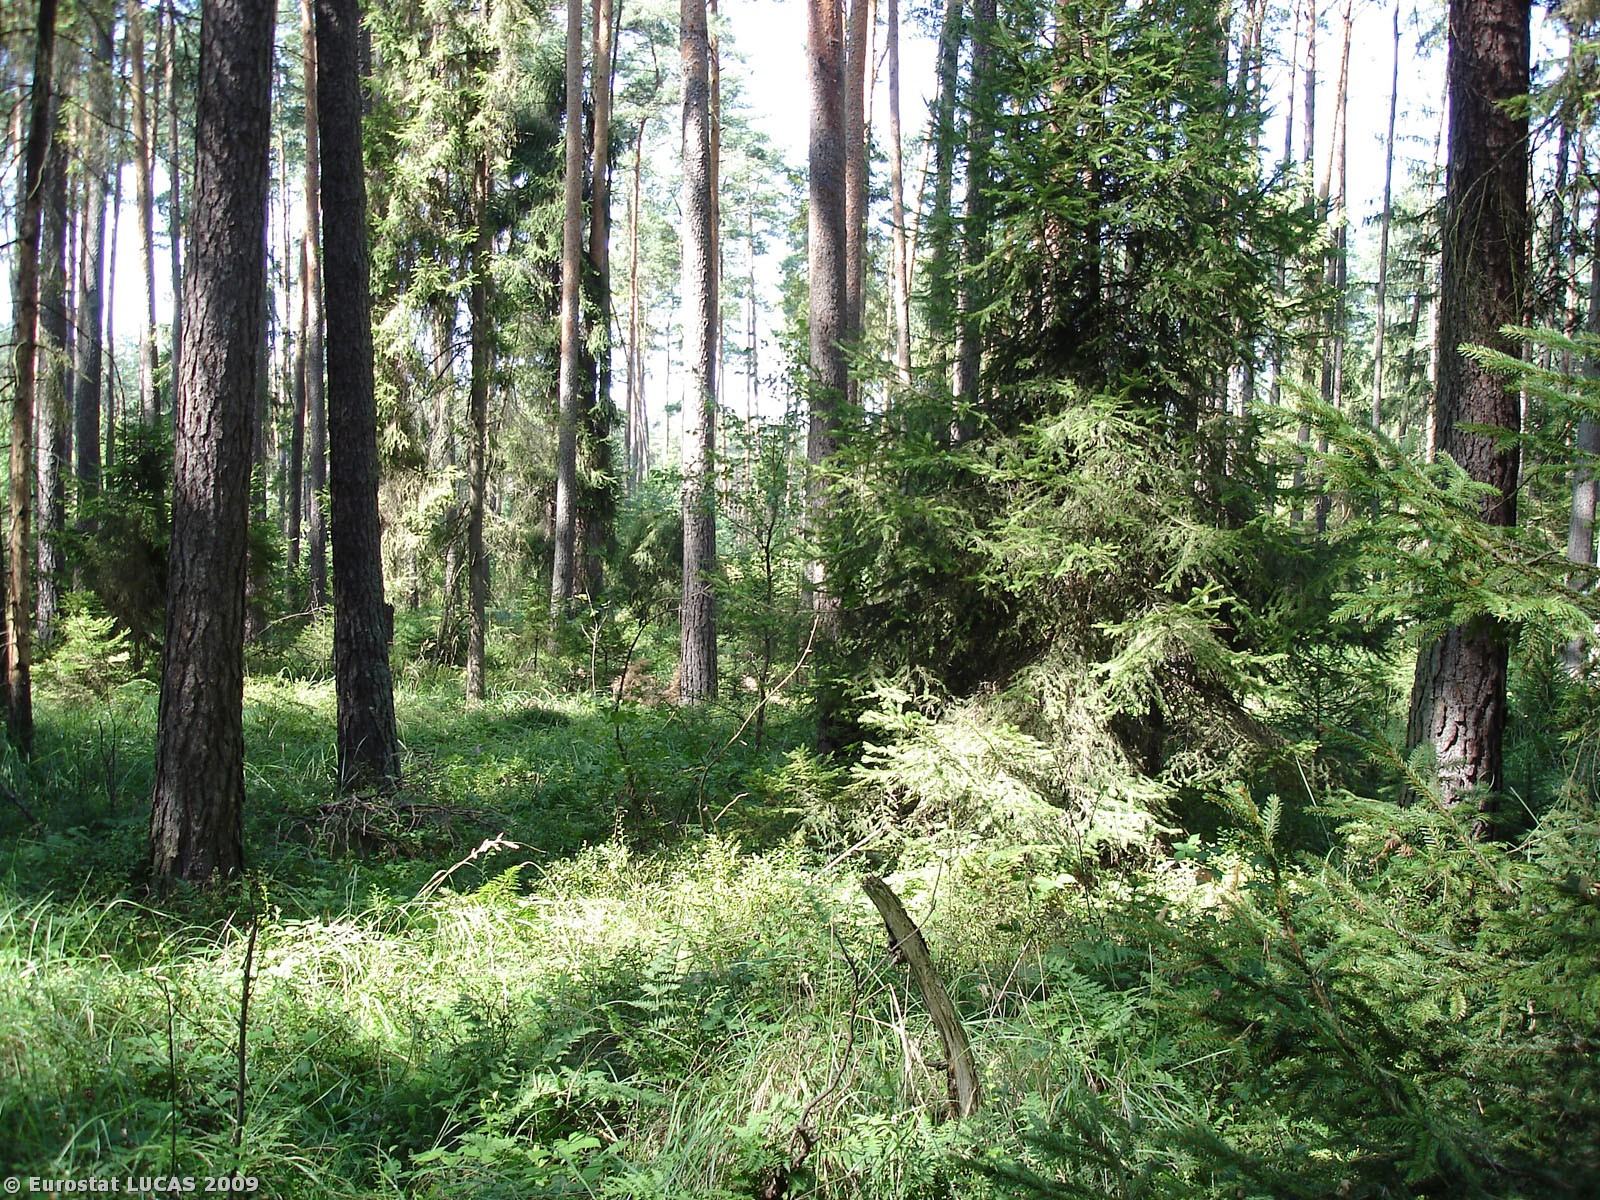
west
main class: Woodland
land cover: Coniferous woodland
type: hemiboreal forest and nemoral coniferous forest and mixed broadleaved-coniferous forest
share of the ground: > 75 %
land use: Forestry
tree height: > 5 m
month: August
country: PL
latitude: 50.9247
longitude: 18.3695
